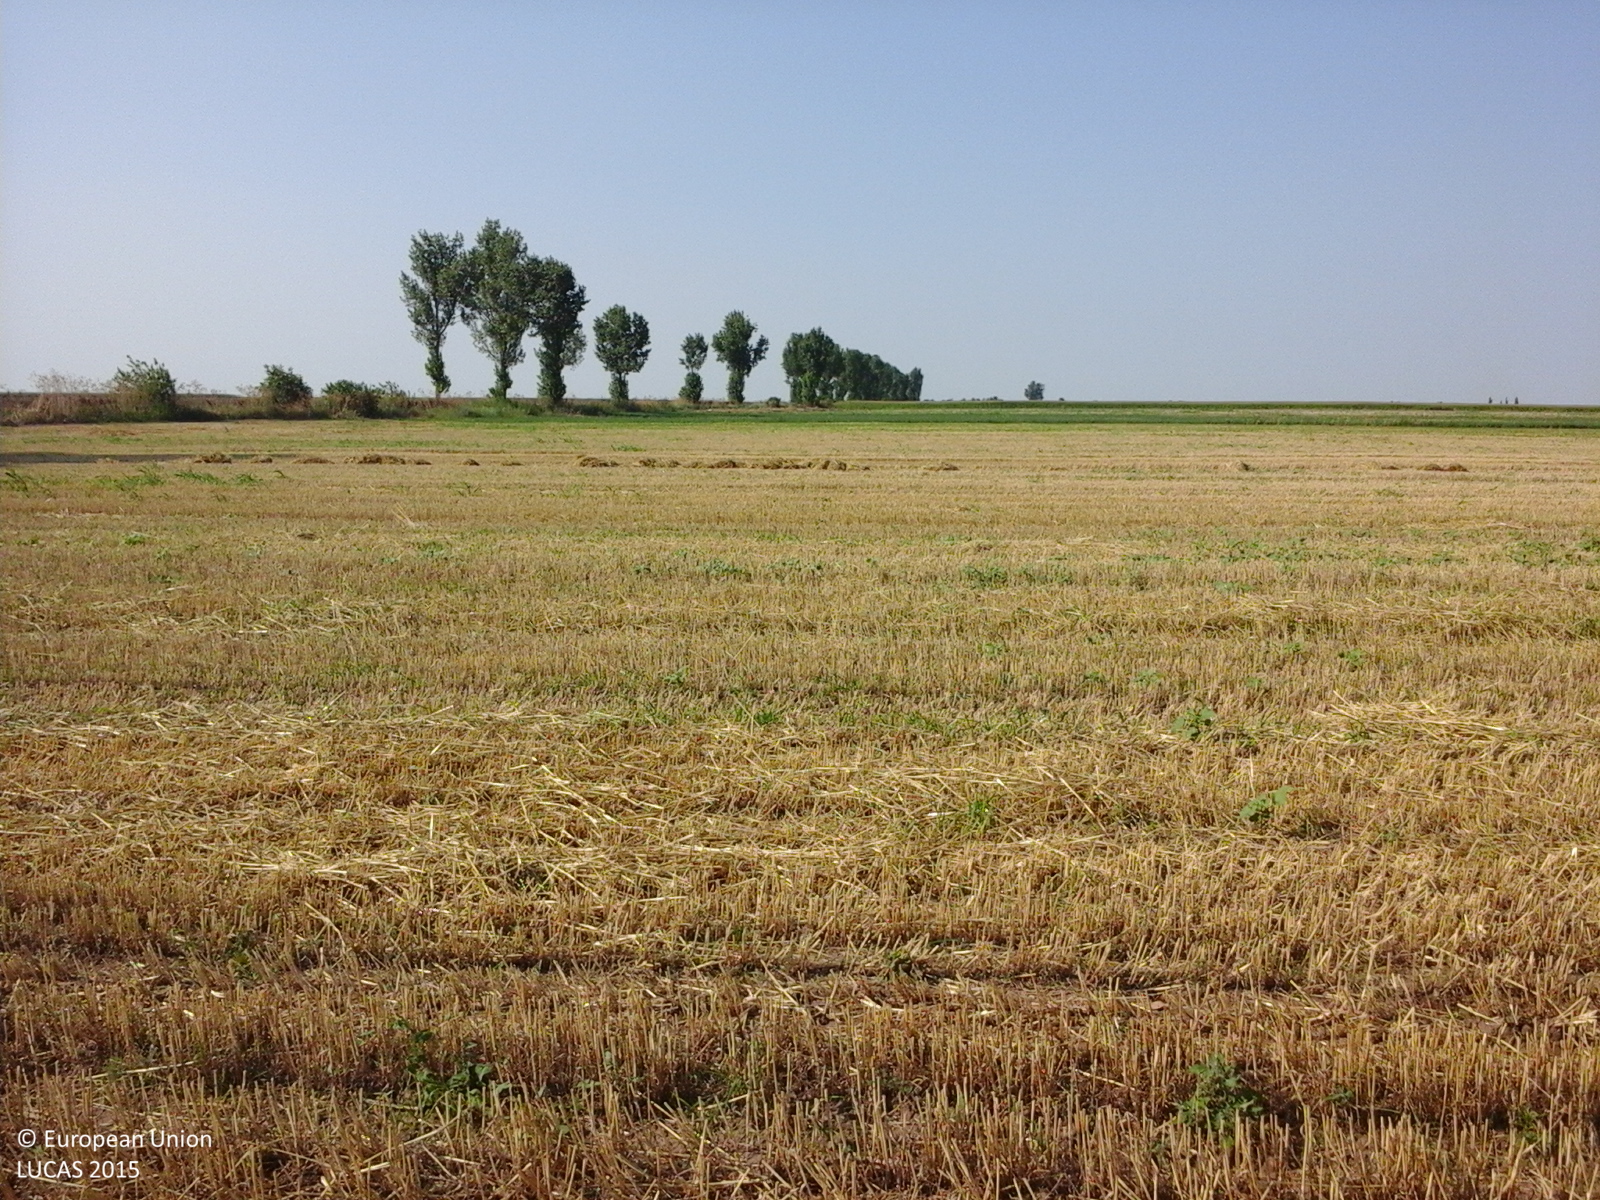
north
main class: Cropland
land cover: Common wheat
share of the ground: 50 - 75 %
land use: Agriculture (excluding fallow land and kitchen gardens)
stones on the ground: < 10 %
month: July
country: RO
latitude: 44.7688
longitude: 27.2596
